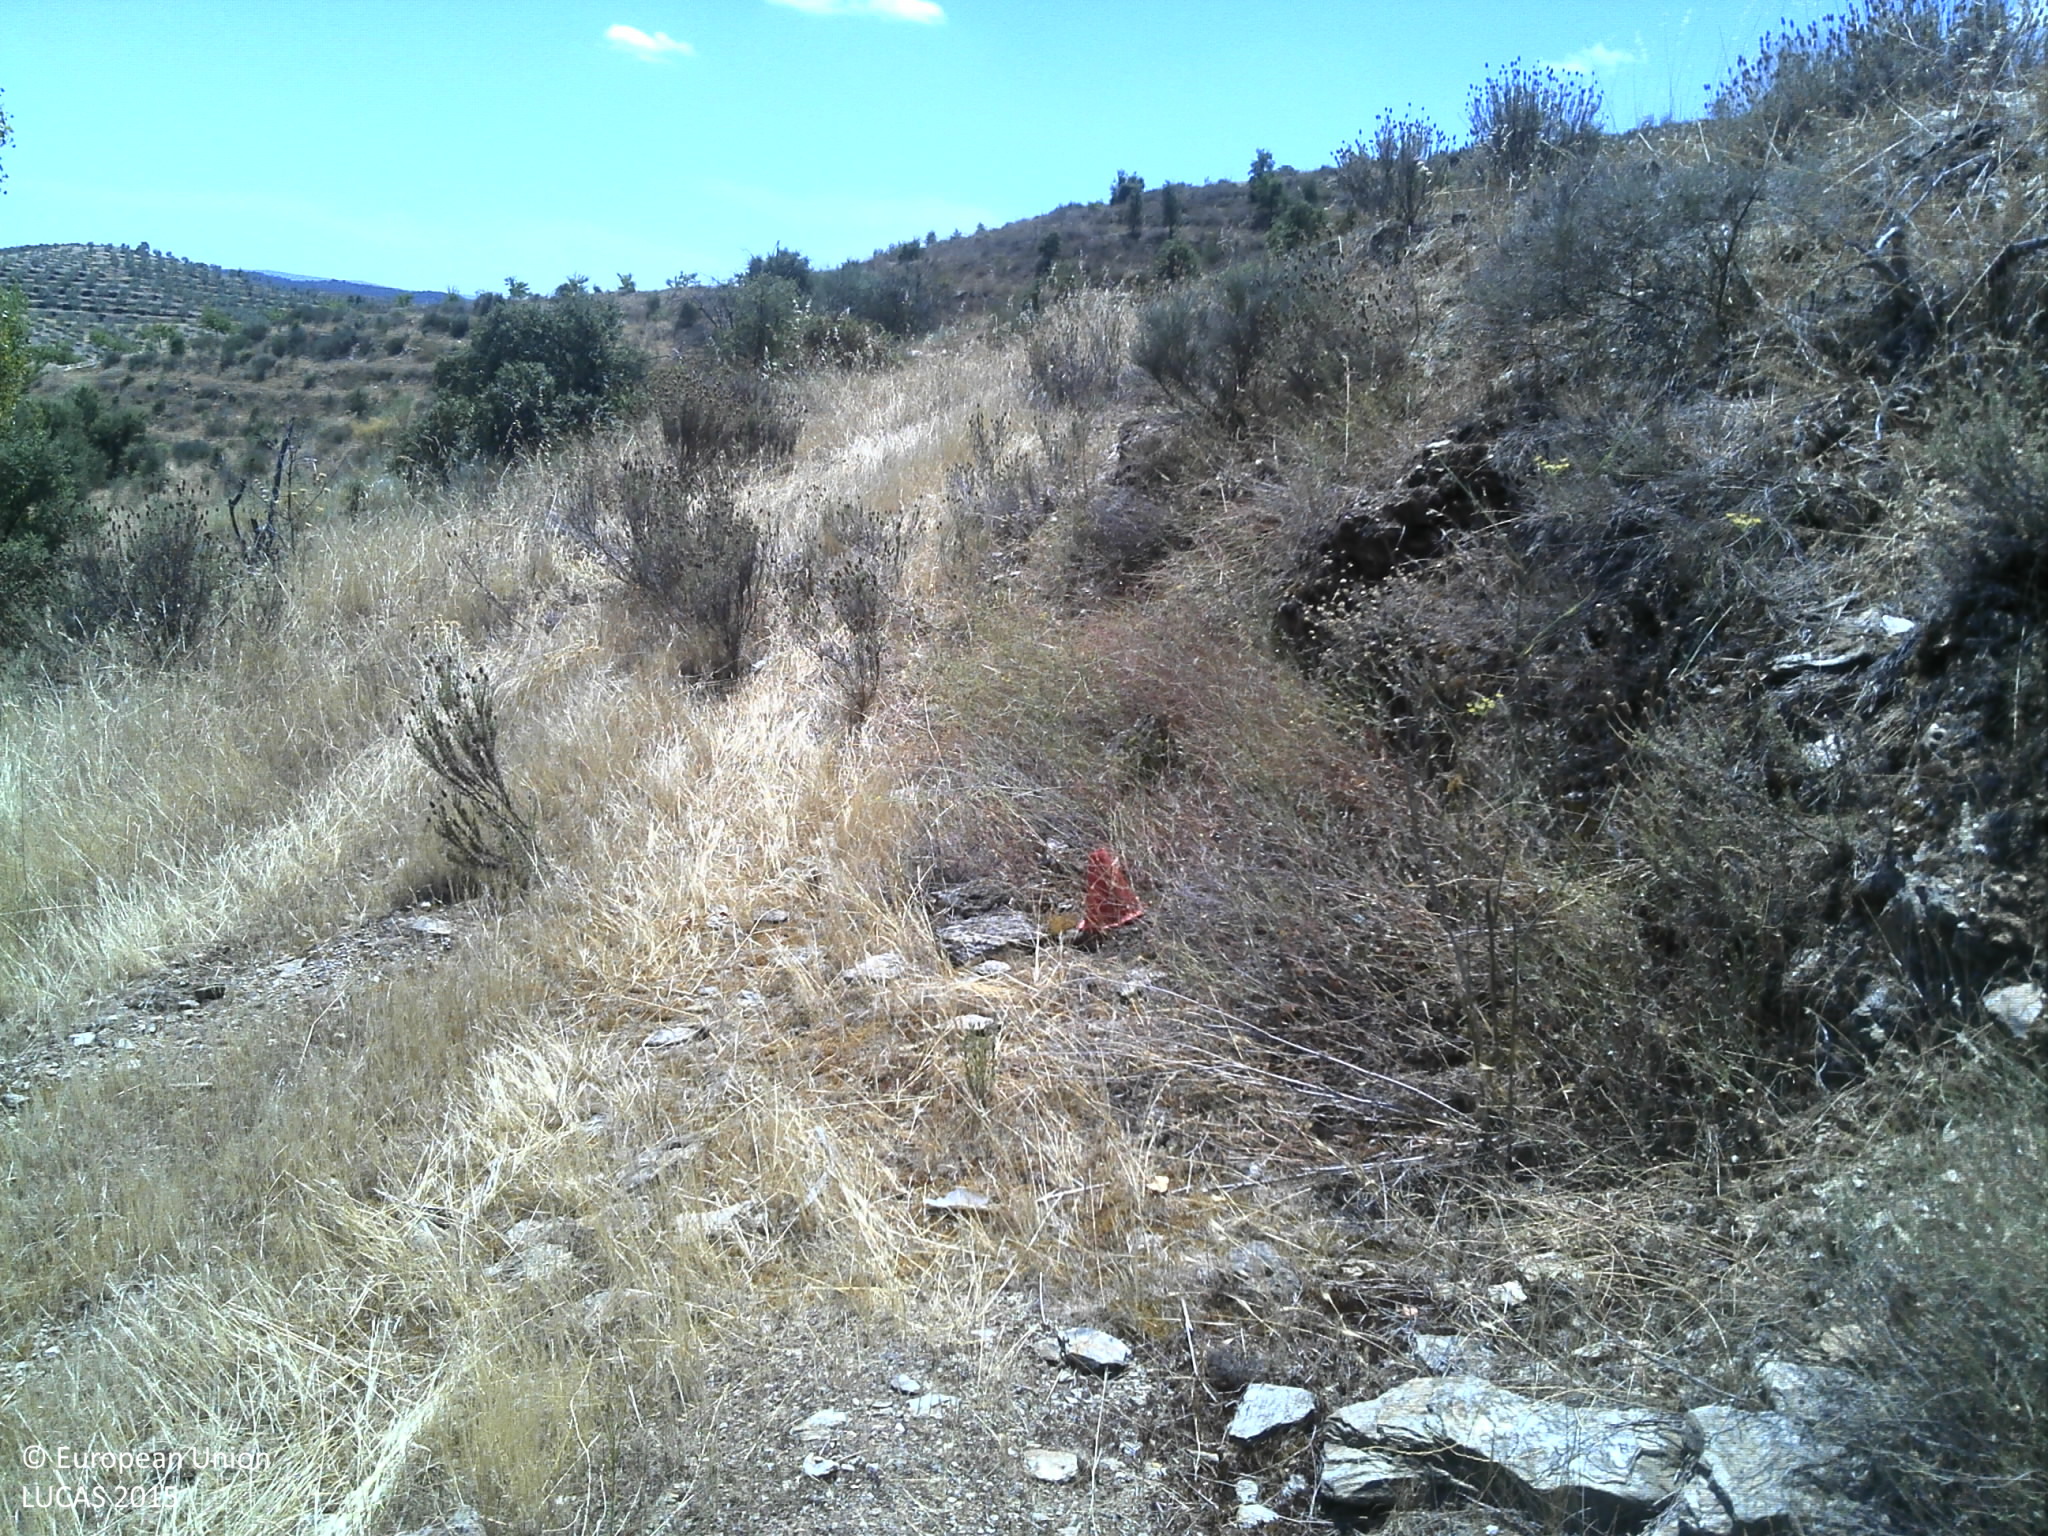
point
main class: Shrubland
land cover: Shrubland with sparse tree cover
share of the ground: > 75 %
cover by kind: shrubs 65 %, unconsolidated bare surface 20 %, herbaceous plants 10 %, broadleaved forest trees 5 %
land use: Abandoned areas
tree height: > 5 m
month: July
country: PT
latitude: 41.3652
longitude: -7.0291
